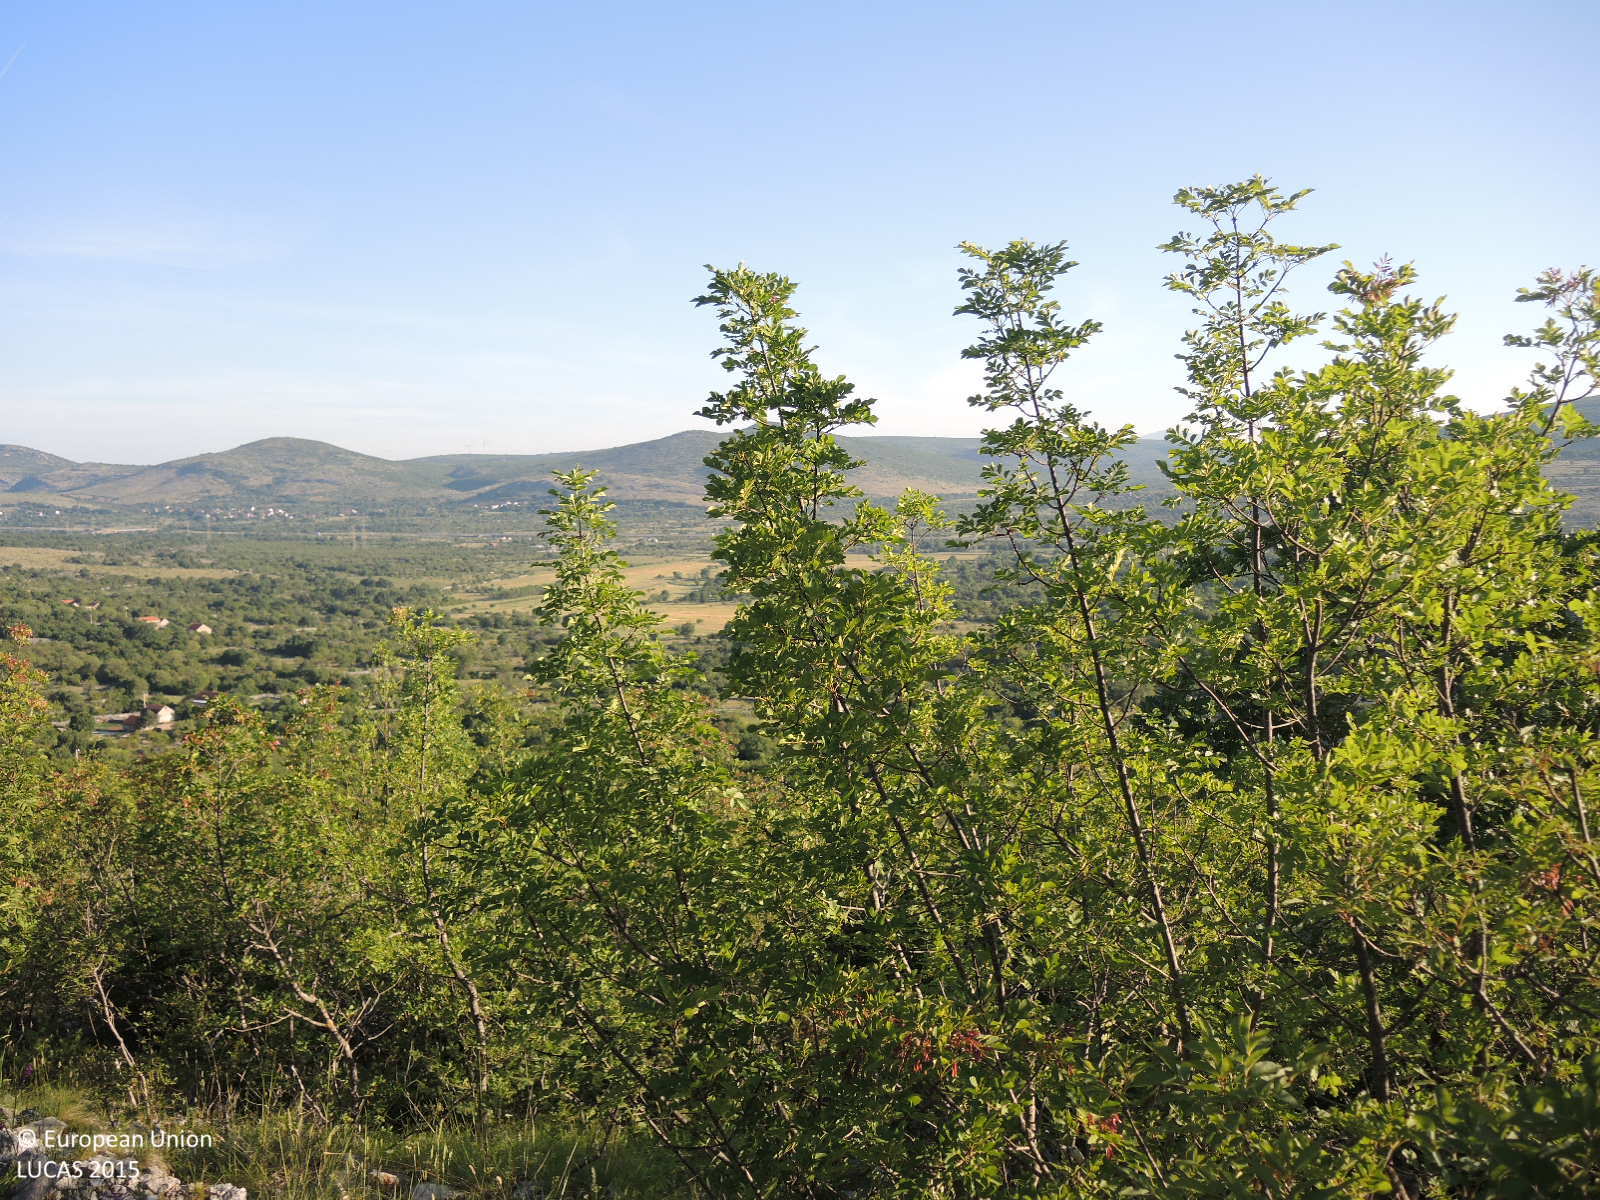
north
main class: Woodland
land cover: Broadleaved woodland
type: thermophilous deciduous forest
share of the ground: > 75 %
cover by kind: broadleaved forest trees 50 %, shrubs 30 %, consolidated bare surface 10 %, unconsolidated bare surface 10 %
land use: Semi-natural and natural areas not in use
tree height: < 5 m
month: June
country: HR
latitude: 43.6614
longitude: 16.1541
